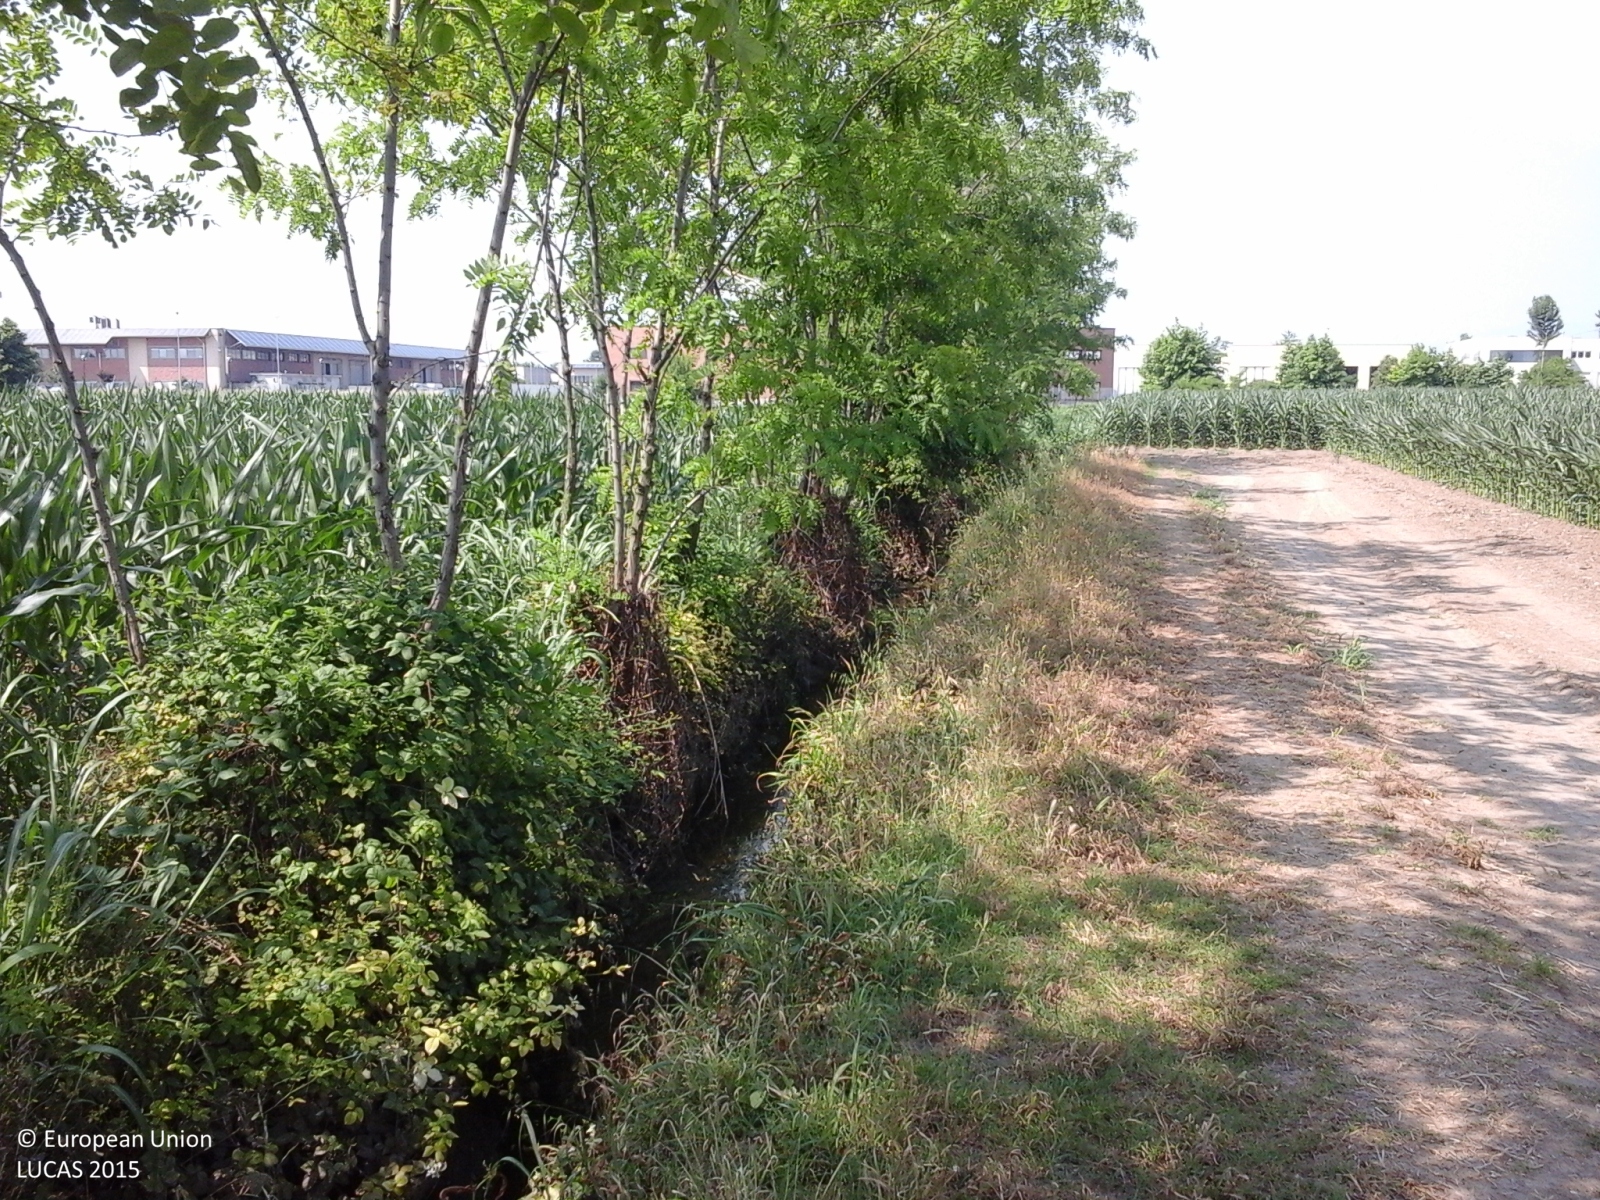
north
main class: Cropland
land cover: Maize
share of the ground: > 75 %
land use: Agriculture (excluding fallow land and kitchen gardens)
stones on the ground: < 10 %
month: June
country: IT
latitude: 45.4141
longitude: 10.1913
